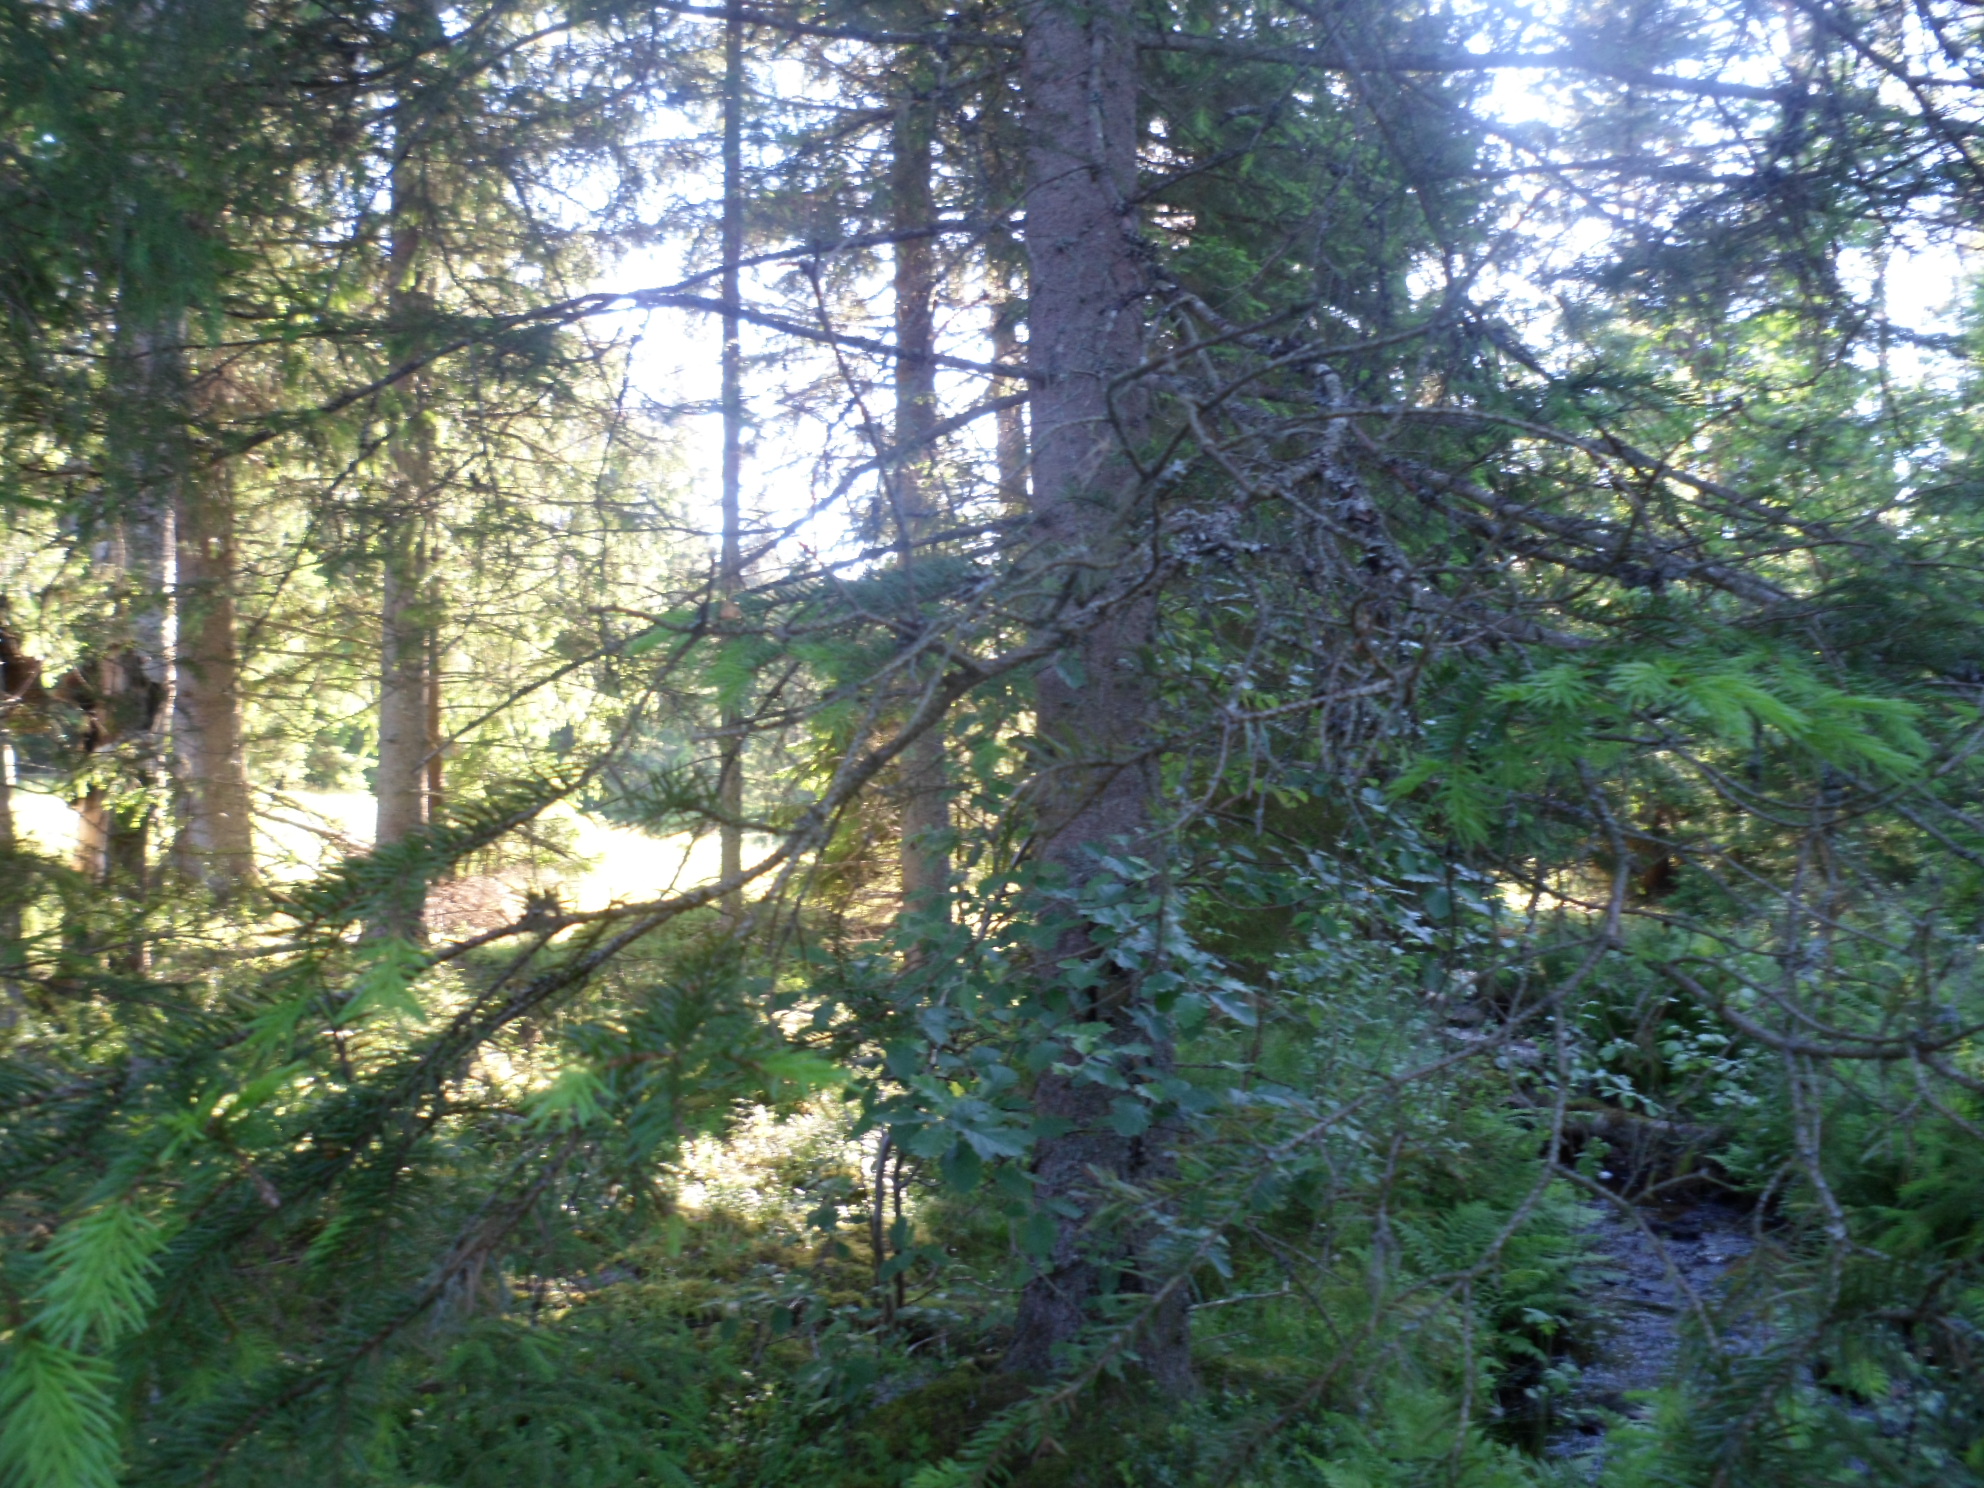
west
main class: Woodland
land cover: Spruce dominated coniferous woodland
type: boreal forest
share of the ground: 50 - 75 %
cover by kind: coniferous forest trees 60 %, shrubs 15 %, herbaceous plants 10 %, lichens and mosses 10 %, broadleaved forest trees 5 %
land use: Forestry
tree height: > 5 m
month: July
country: SE
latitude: 57.5904
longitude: 14.3616
